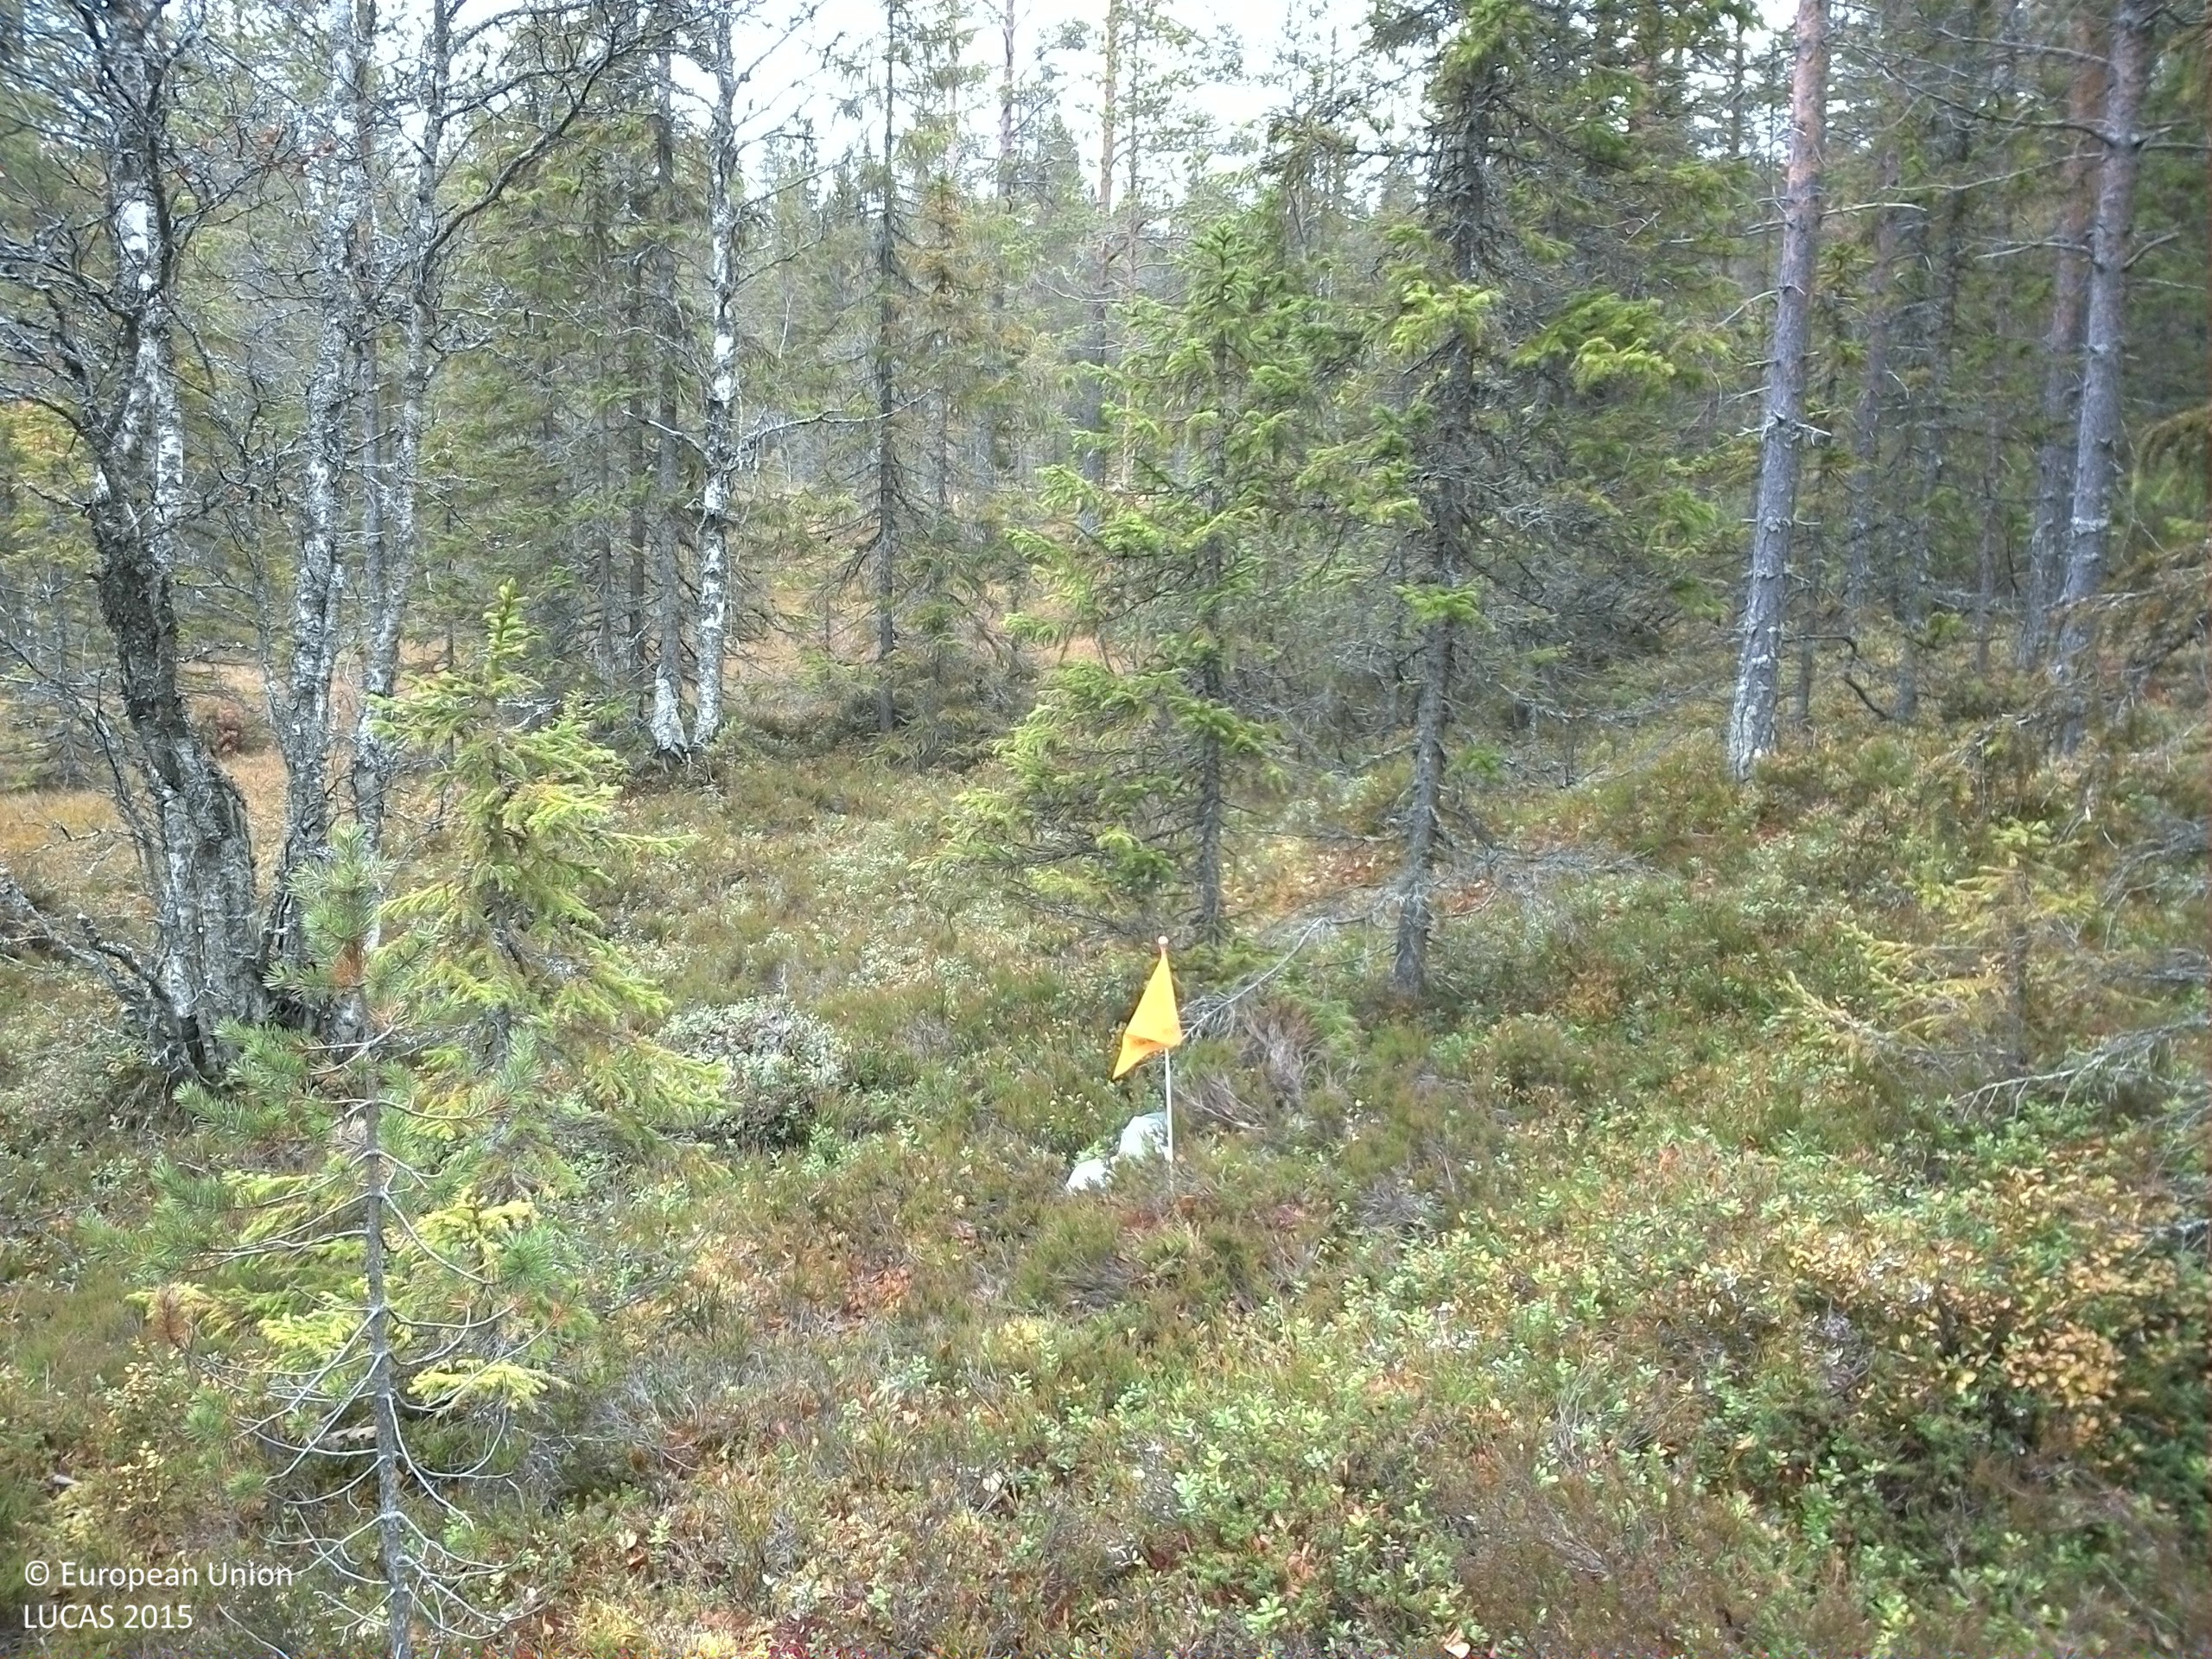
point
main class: Woodland
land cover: Spruce dominated mixed woodland
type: boreal forest
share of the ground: 25 - 50 %
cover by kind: shrubs 35 %, coniferous forest trees 30 %, lichens and mosses 20 %, broadleaved forest trees 15 %
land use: Forestry
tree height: > 5 m
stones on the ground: < 10 %
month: October
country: SE
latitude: 61.4291
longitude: 14.3904
